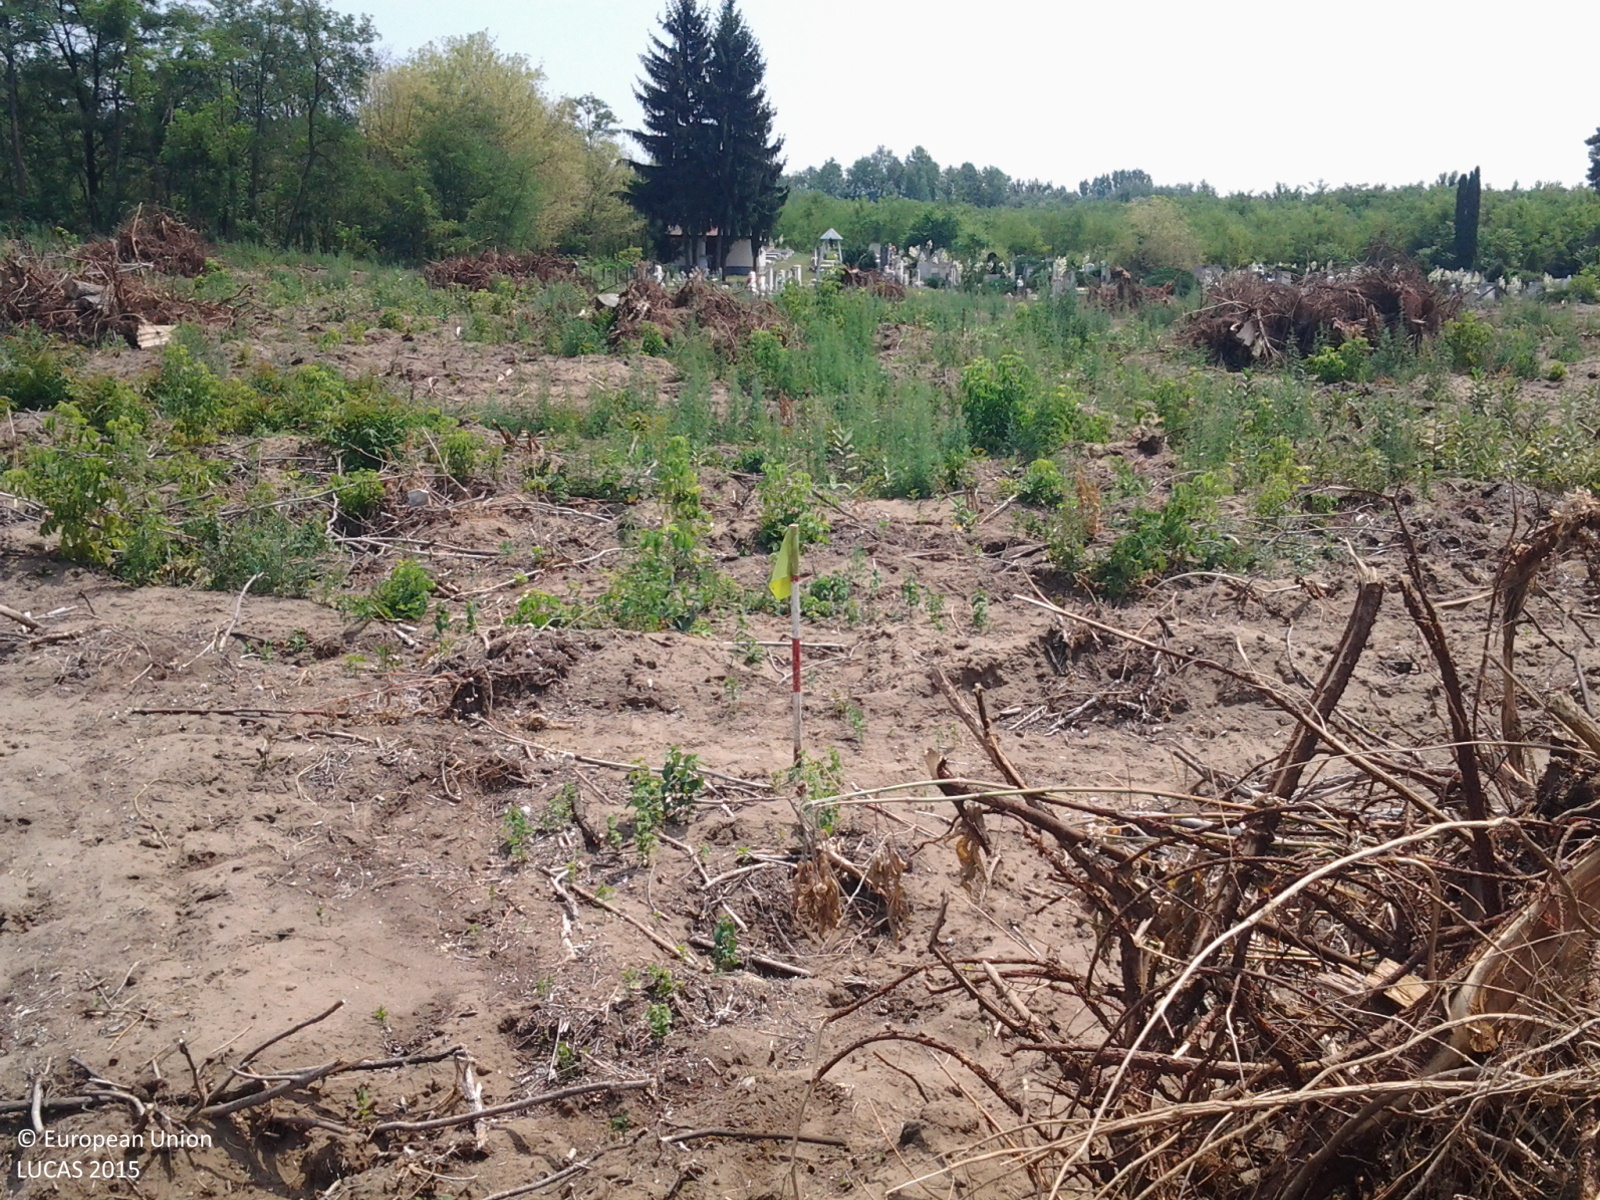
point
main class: Grassland
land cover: Spontaneously vegetated surfaces
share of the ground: 50 - 75 %
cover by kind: herbaceous plants 60 %, unconsolidated bare surface 40 %
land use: Forestry
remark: Clear cut
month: July
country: HU
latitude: 47.4120
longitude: 19.9250
